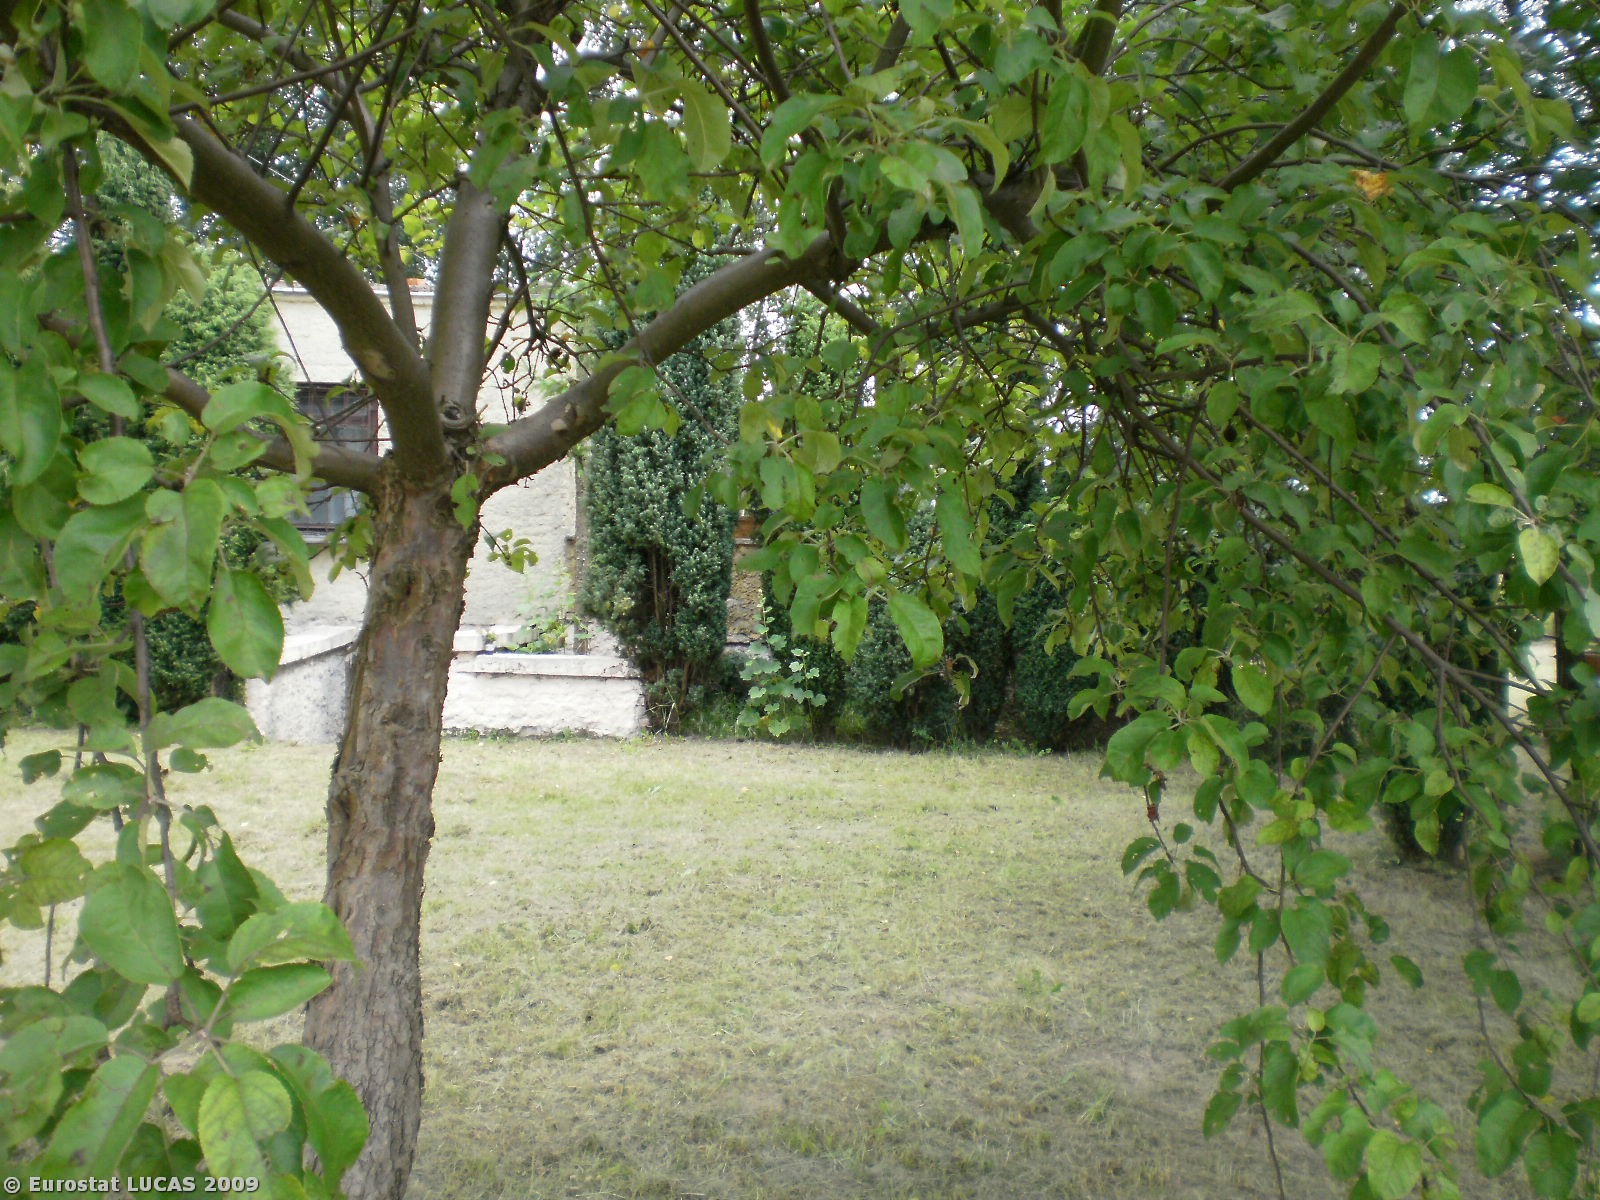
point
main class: Cropland
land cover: Apple fruit
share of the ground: 50 - 75 %
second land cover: Grassland with sparse tree/shrub cover
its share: 50 - 75 %
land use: Kitchen garden
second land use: Residential
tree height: < 5 m
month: July
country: PL
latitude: 52.6083
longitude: 20.8070
